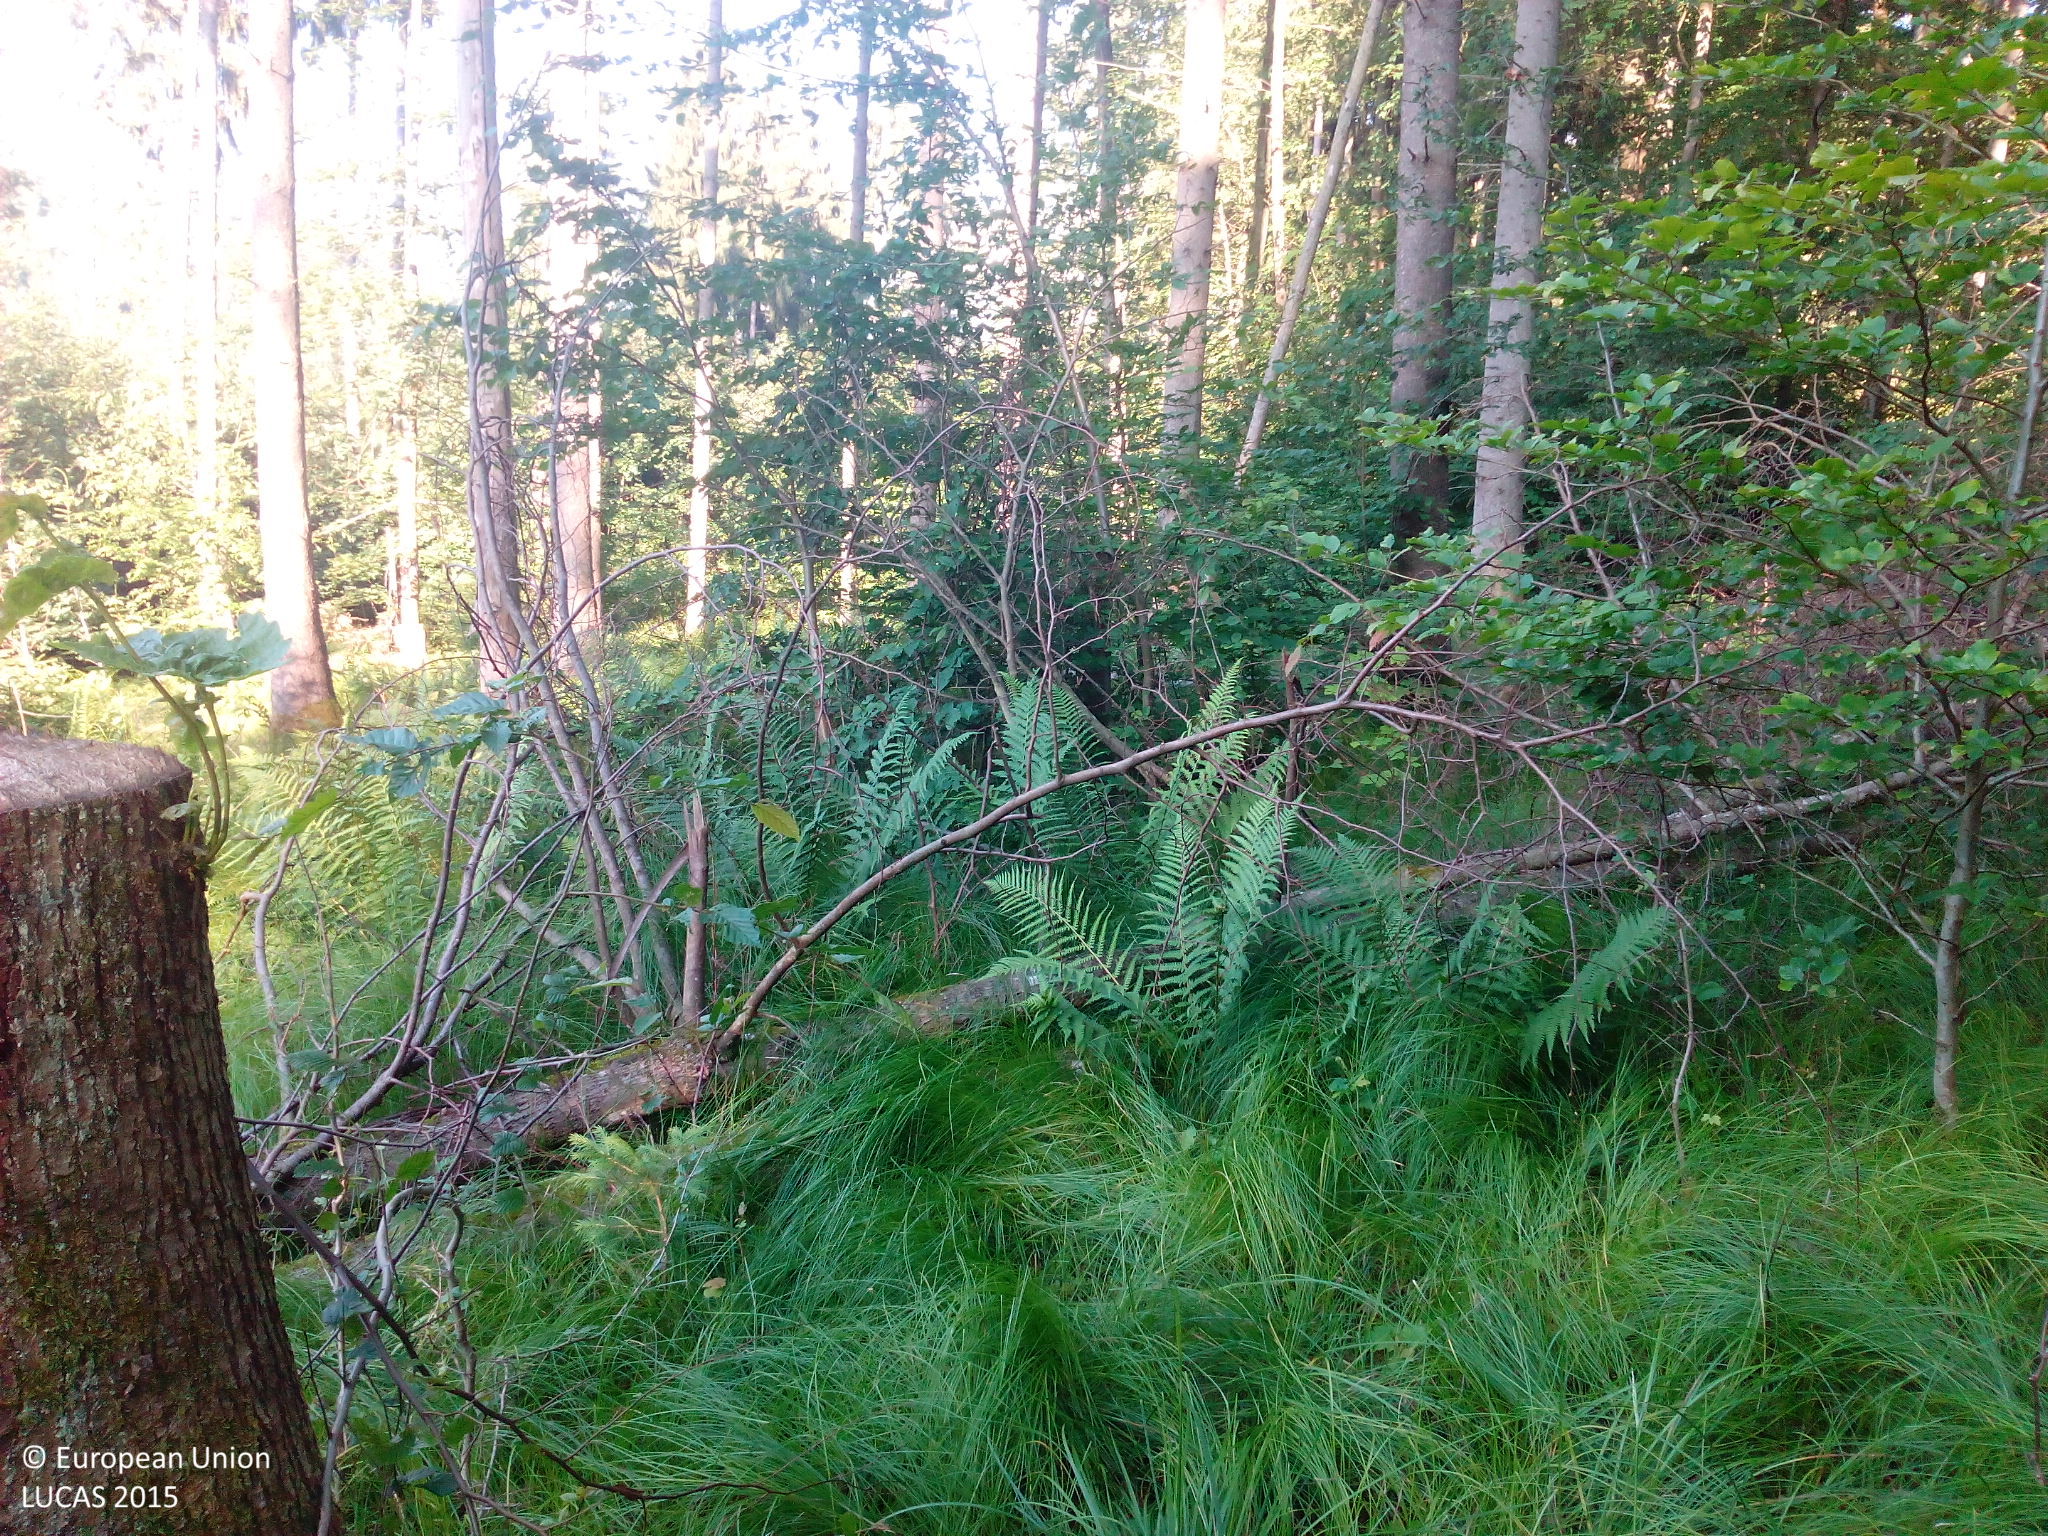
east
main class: Woodland
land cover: Spruce dominated mixed woodland
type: hemiboreal forest and nemoral coniferous forest and mixed broadleaved-coniferous forest
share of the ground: 50 - 75 %
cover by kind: coniferous forest trees 25 %, broadleaved forest trees 25 %, shrubs 25 %, herbaceous plants 25 %
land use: Forestry
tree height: > 5 m
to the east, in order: Spruce dominated mixed woodland; Tracks; Spruce dominated mixed woodland; Tracks; Grassland without tree/shrub cover
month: June
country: DE
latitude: 48.5997
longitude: 9.3901
